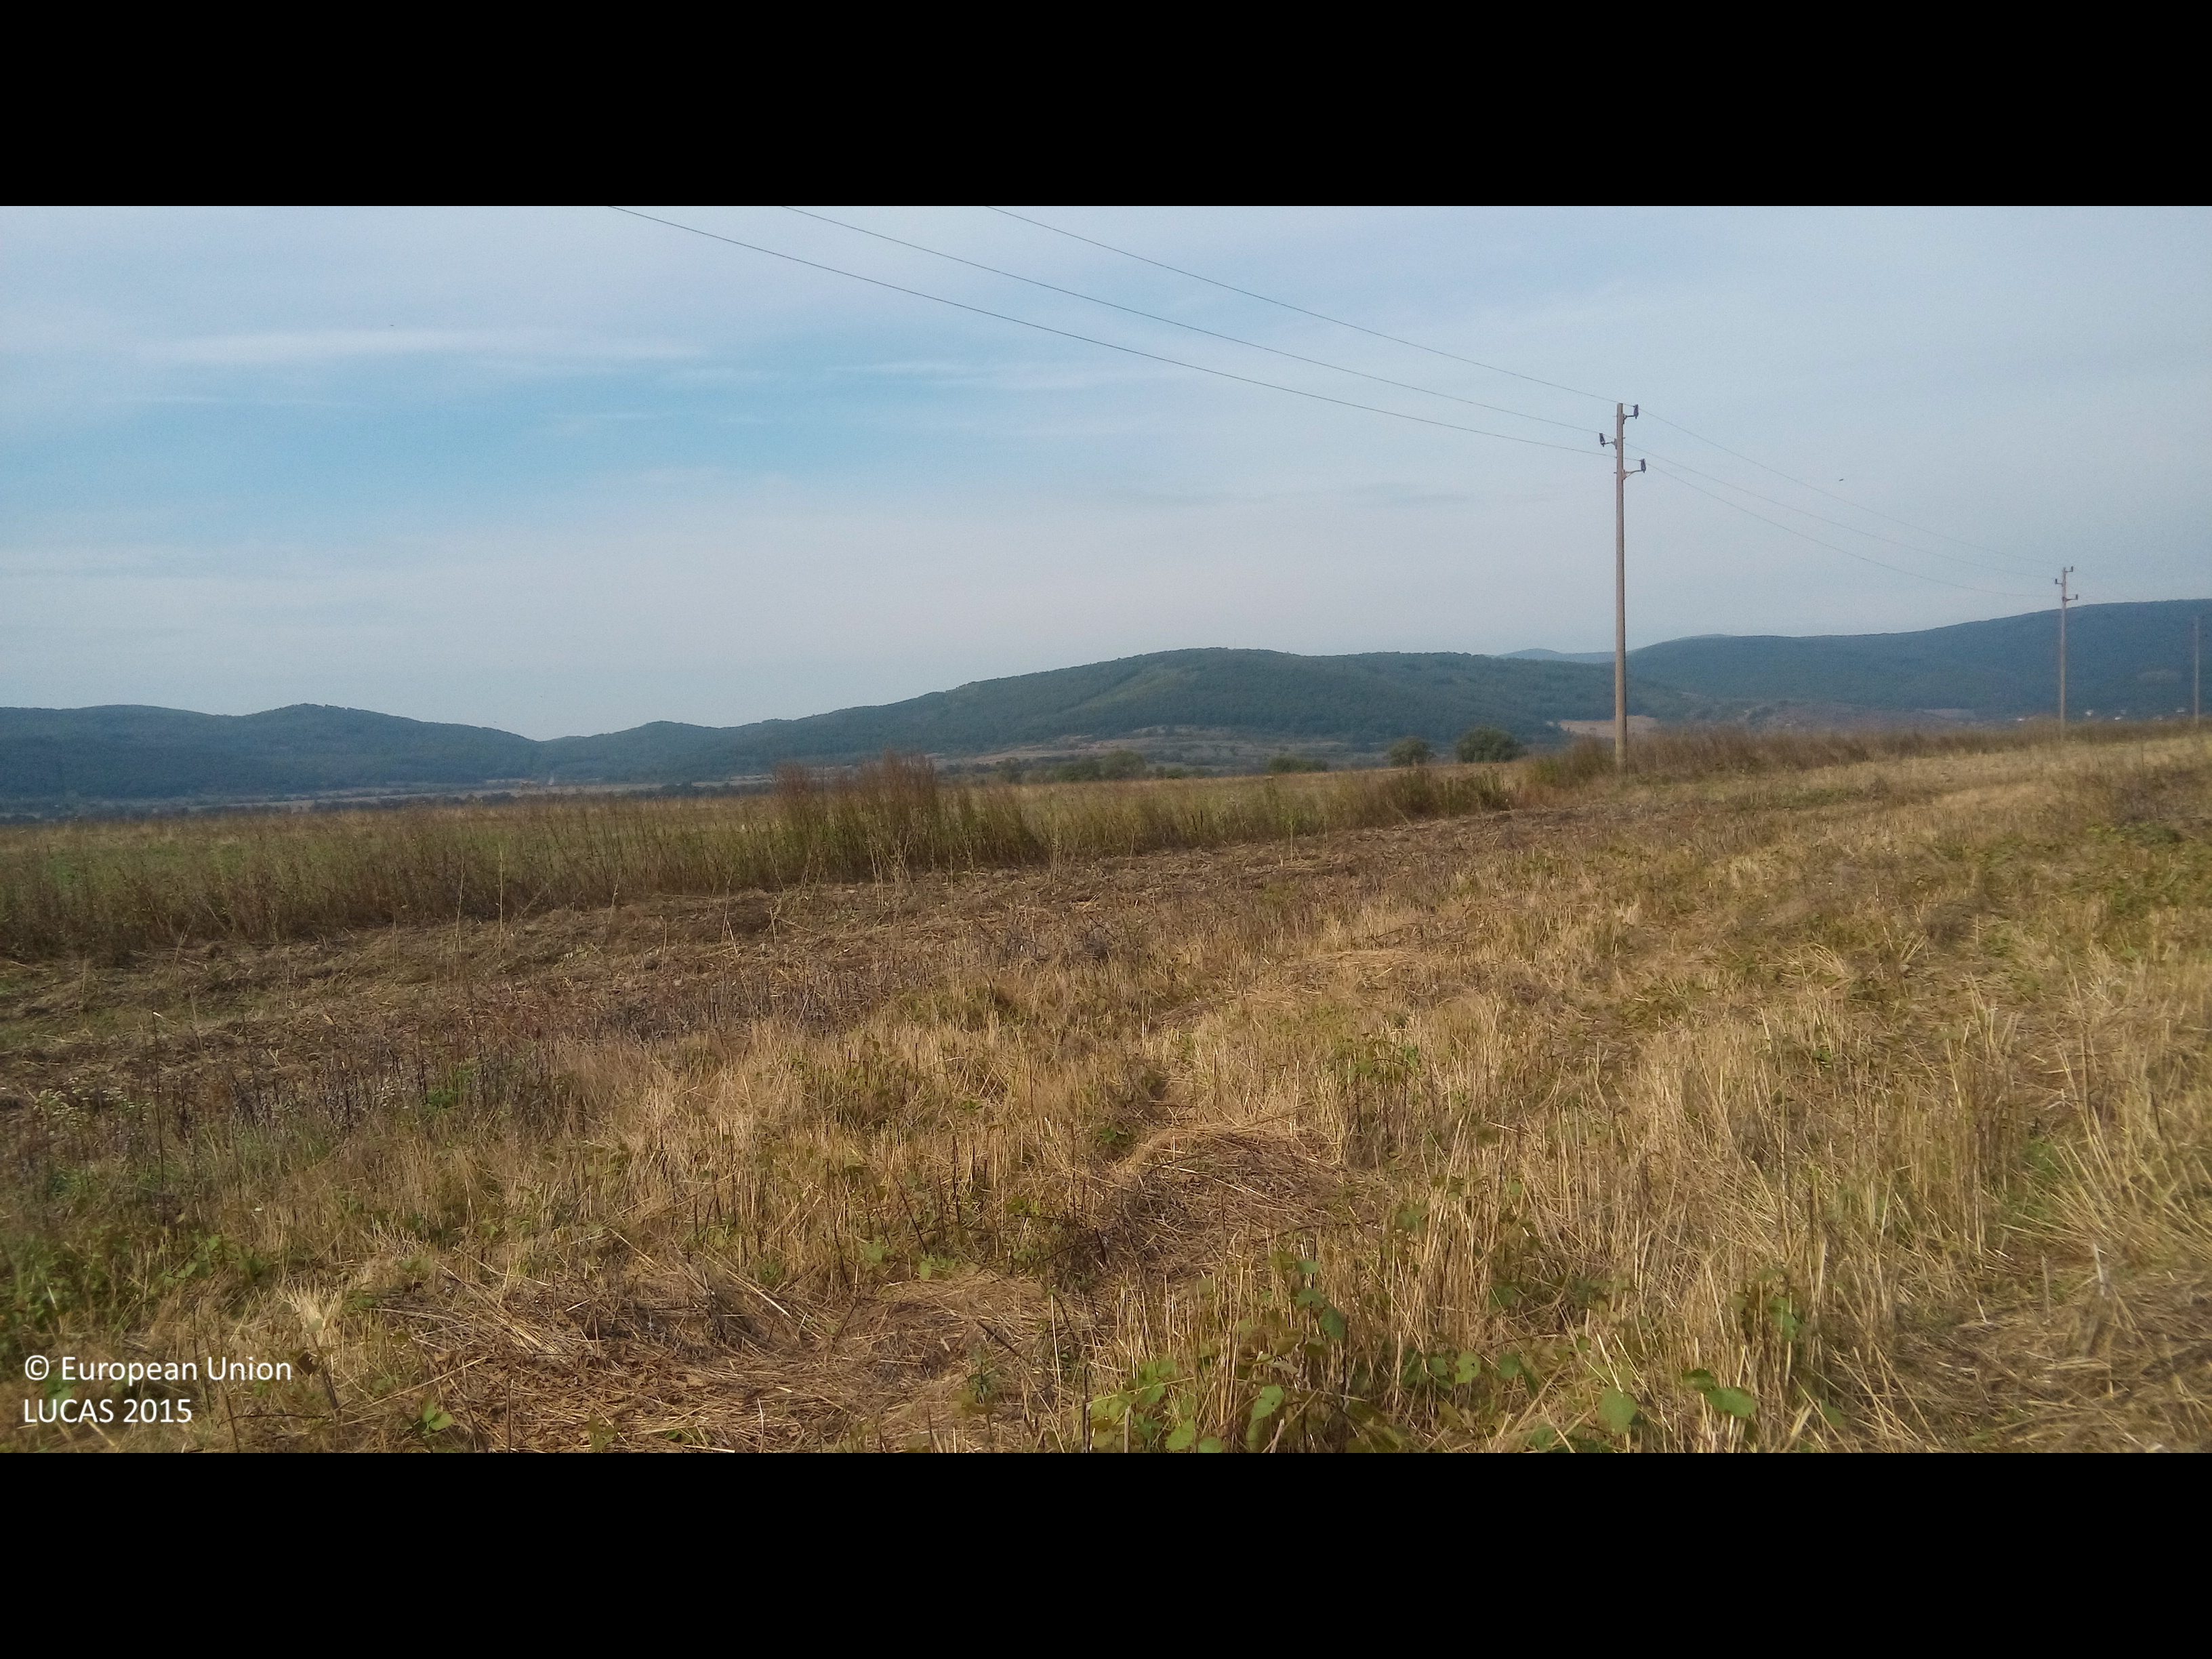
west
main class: Cropland
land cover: Common wheat
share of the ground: 50 - 75 %
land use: Agriculture (excluding fallow land and kitchen gardens)
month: October
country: BG
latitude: 42.7390
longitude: 23.8582
